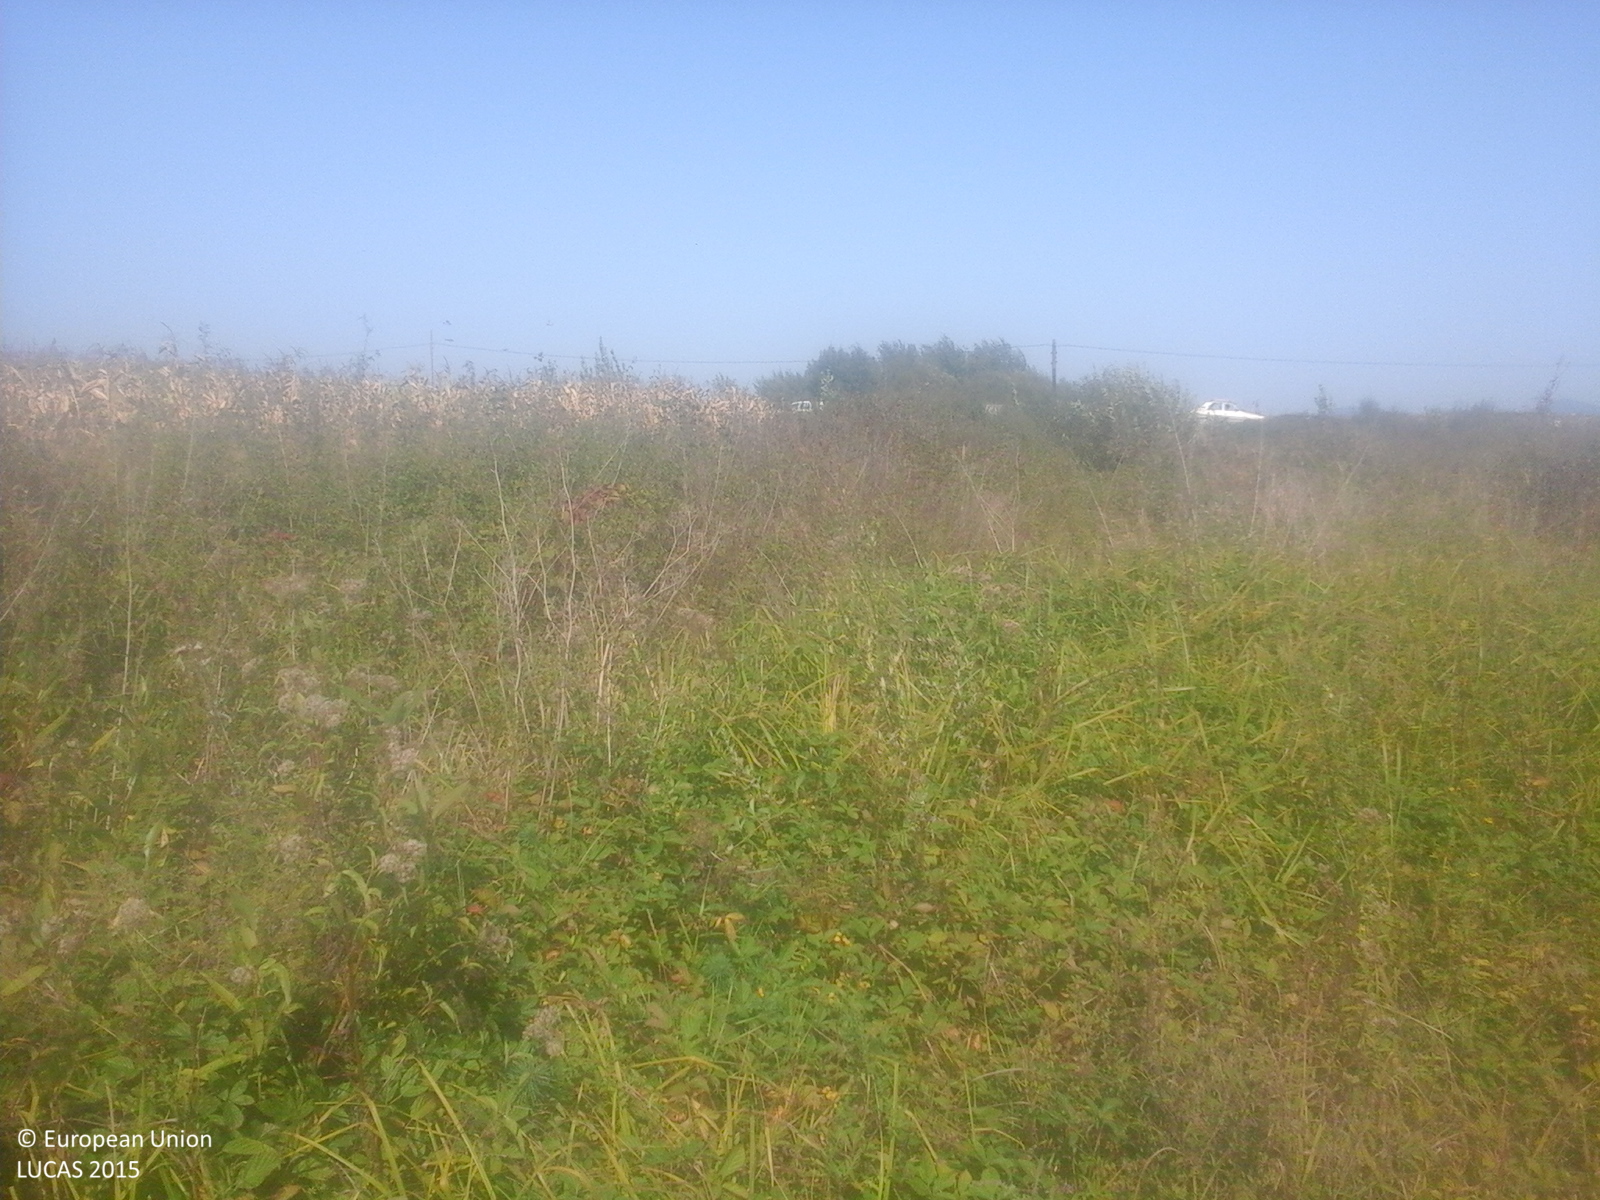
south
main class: Cropland
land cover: Maize
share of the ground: > 75 %
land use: Agriculture (excluding fallow land and kitchen gardens)
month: September
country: RO
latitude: 46.6733
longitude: 22.3243
